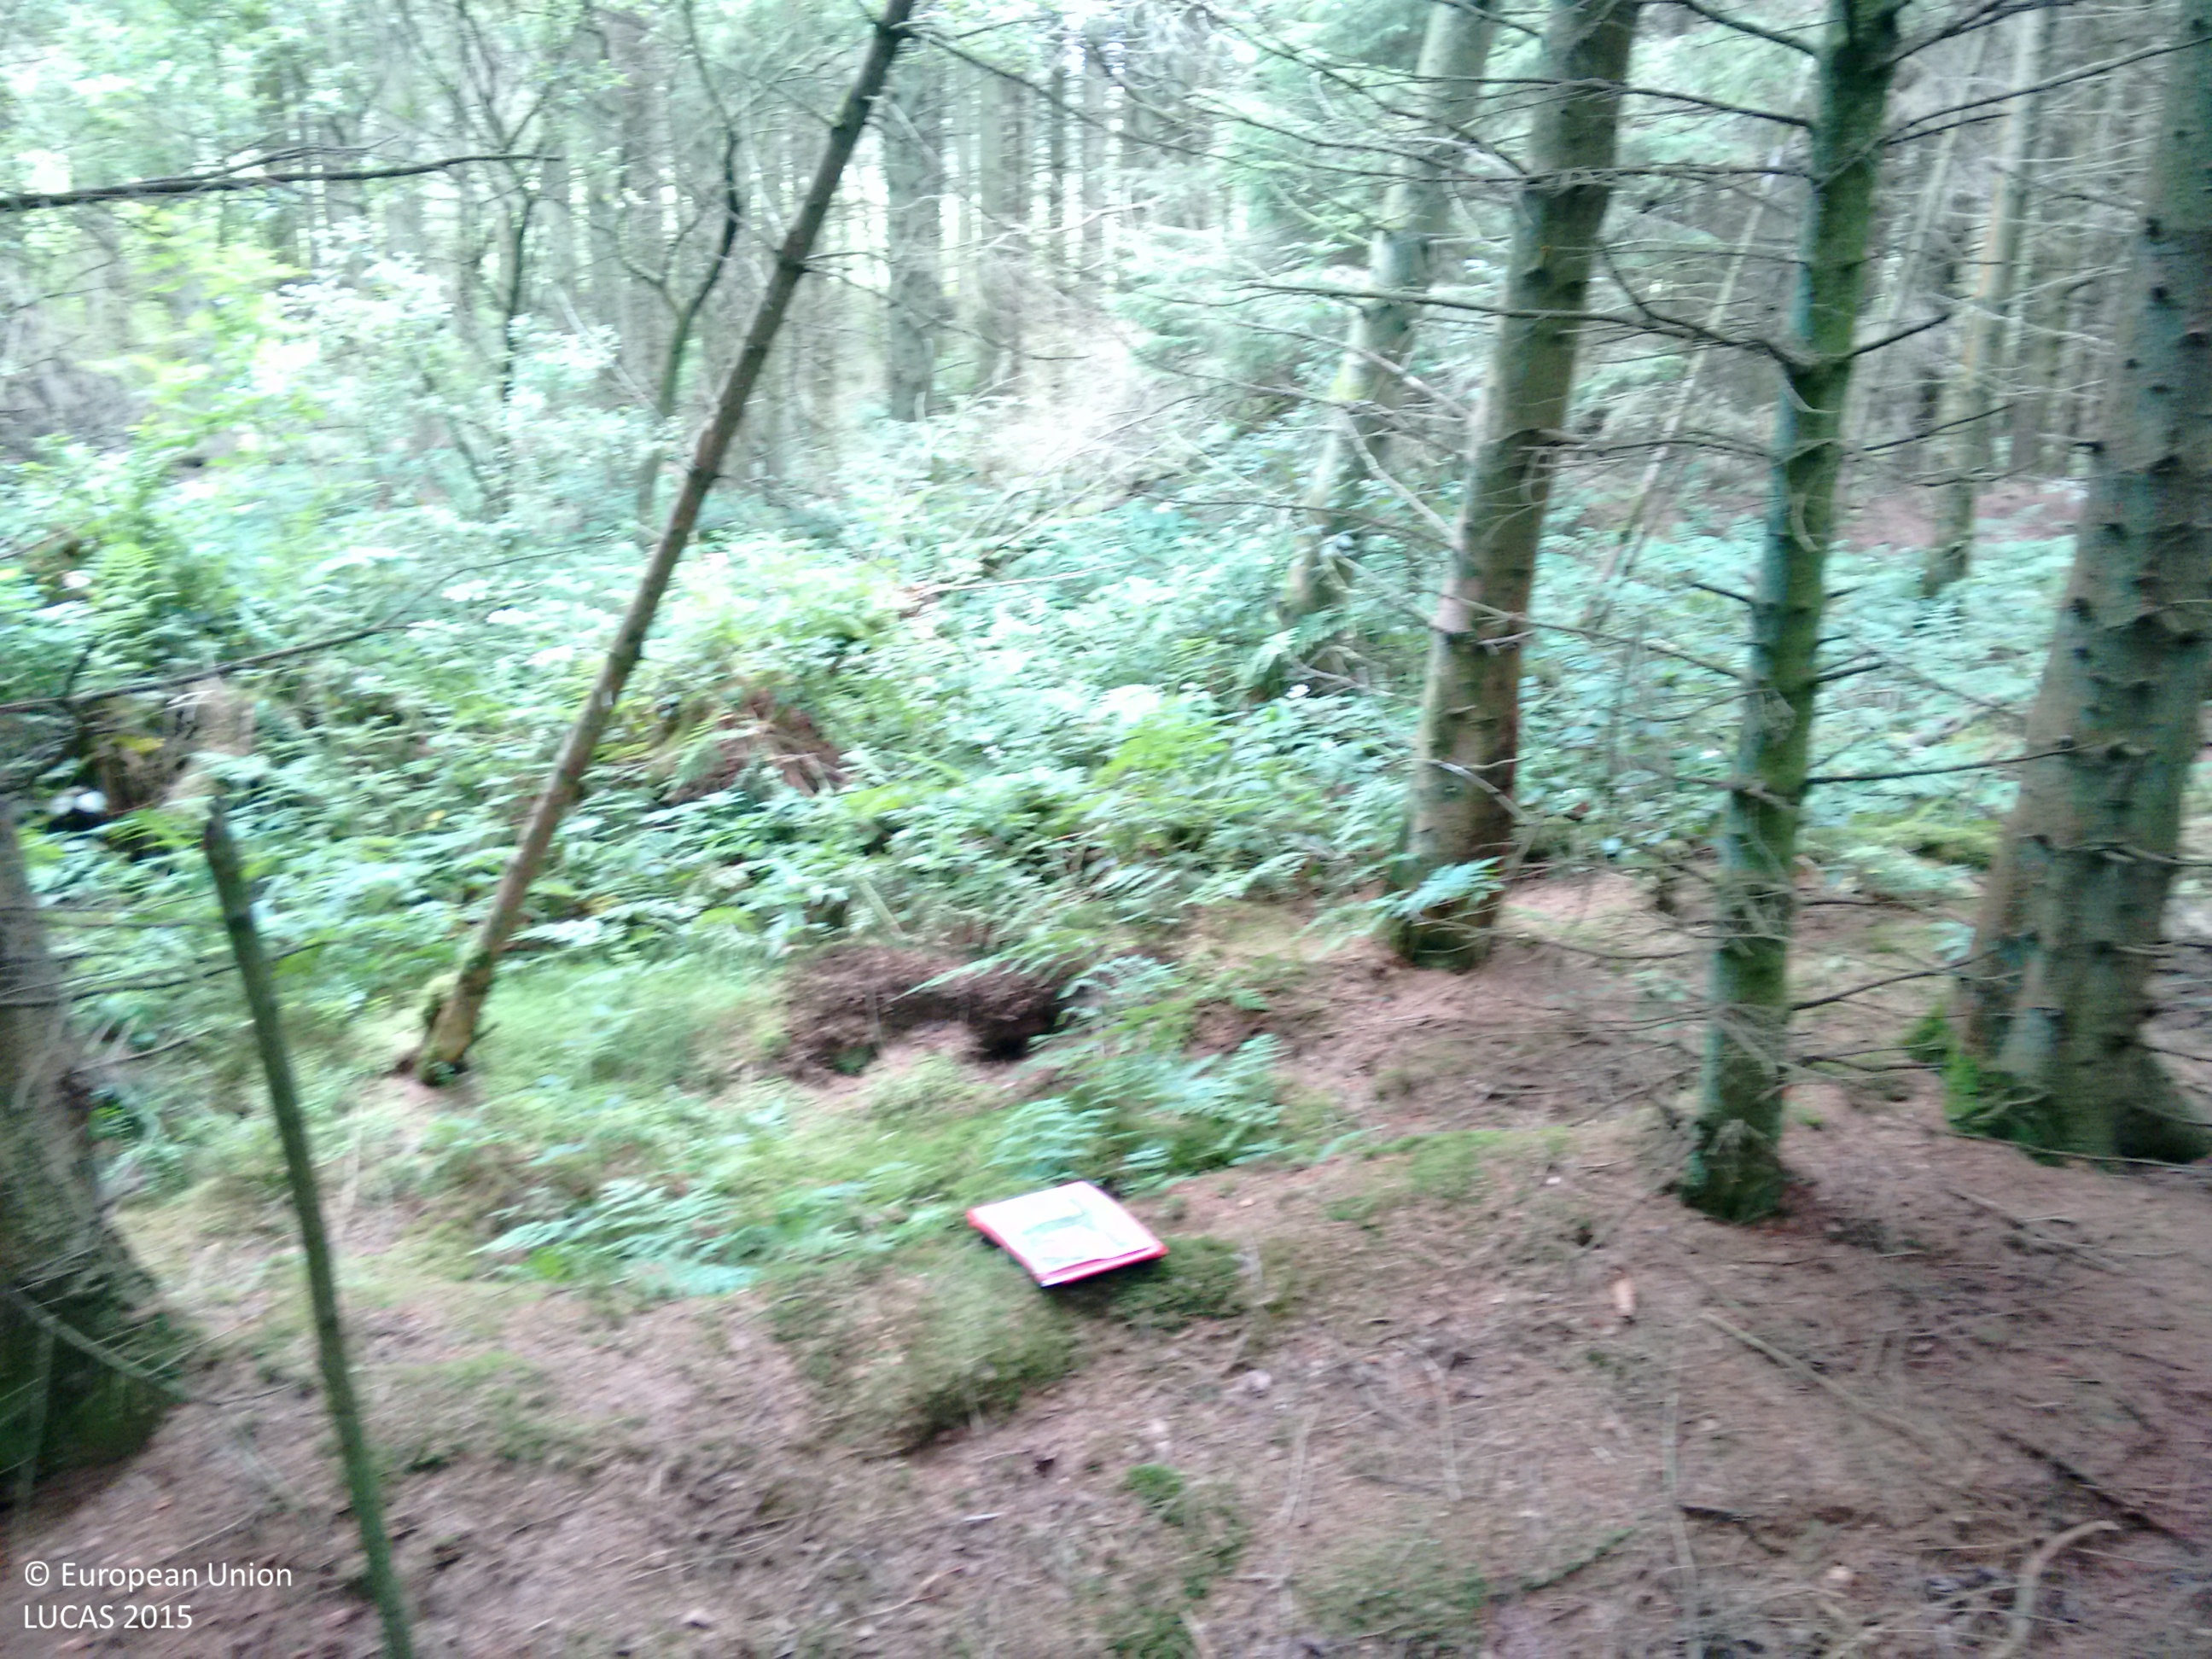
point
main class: Woodland
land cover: Spruce dominated mixed woodland
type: exotic forest
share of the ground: > 75 %
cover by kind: coniferous forest trees 75 %, broadleaved forest trees 25 %
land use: Forestry
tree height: > 5 m
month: August
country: GB
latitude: 53.0435
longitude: -3.4930
